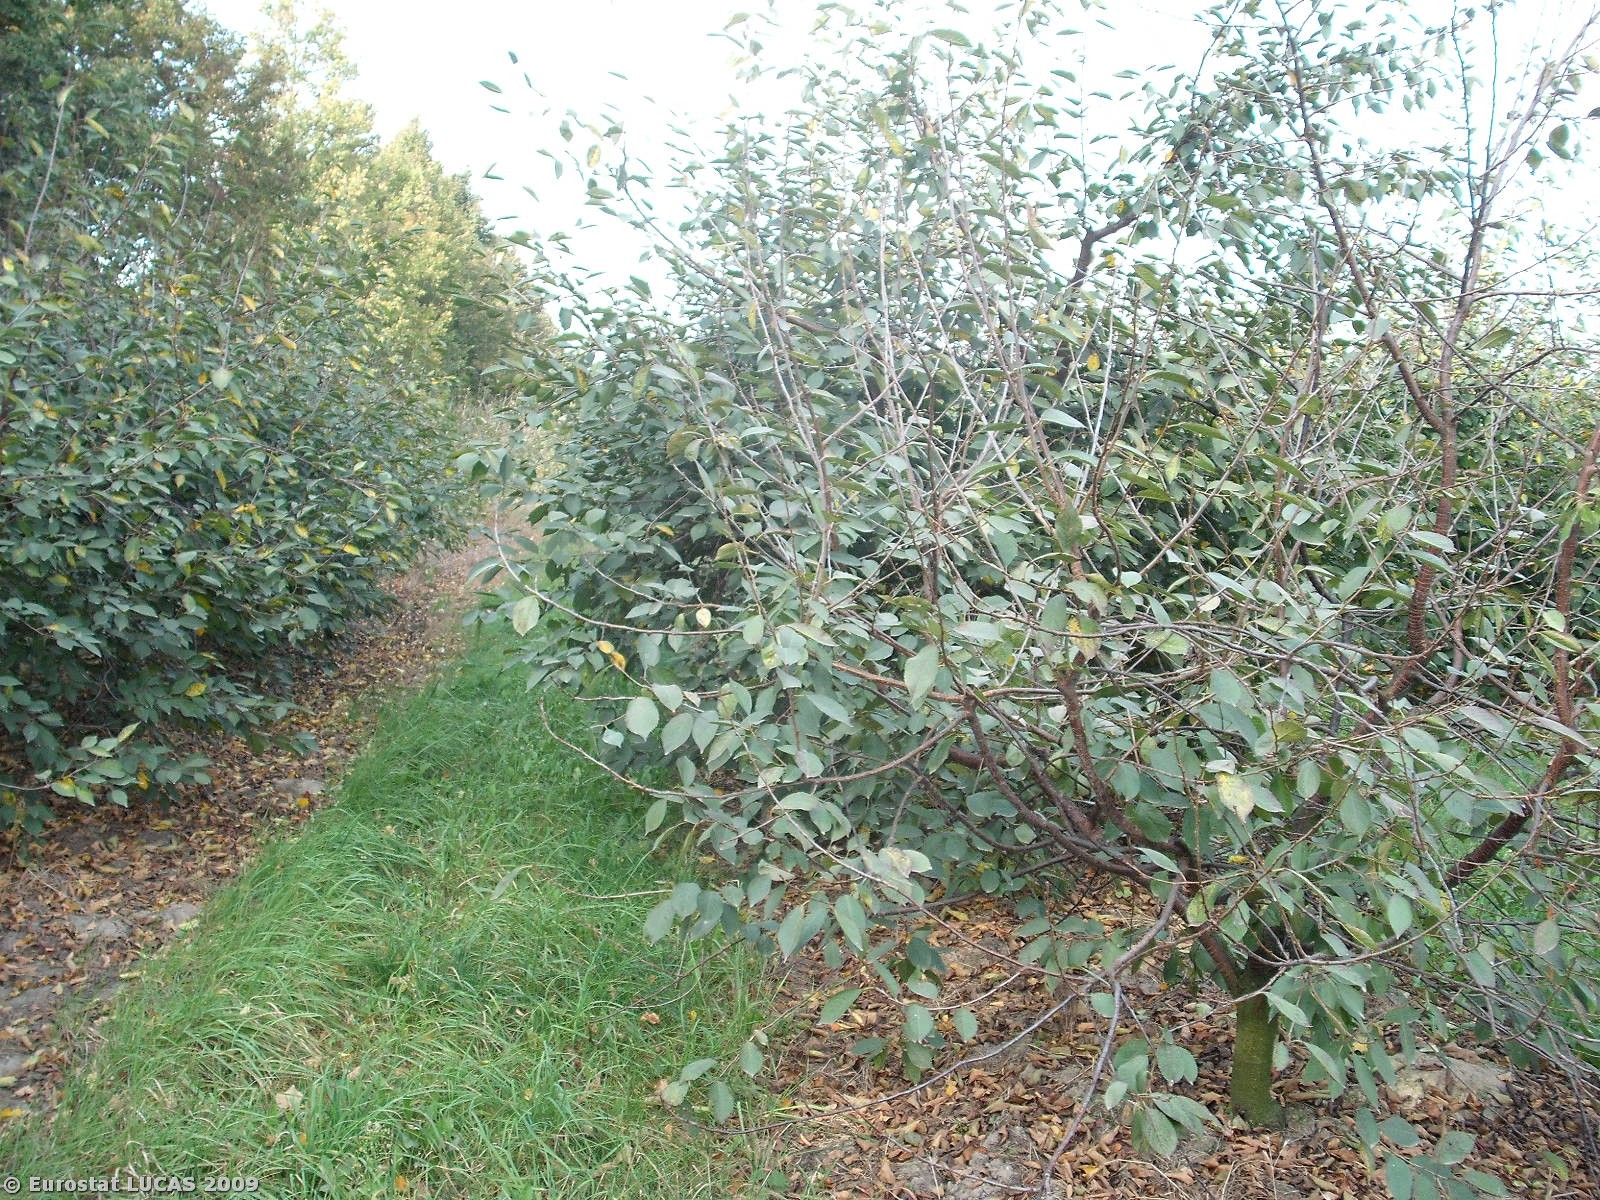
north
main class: Cropland
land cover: Cherry fruit
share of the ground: 50 - 75 %
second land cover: Grassland with sparse tree/shrub cover
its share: > 75 %
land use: Agriculture (excluding fallow land and kitchen gardens)
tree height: < 5 m
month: September
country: PL
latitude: 51.6649
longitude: 20.6084
